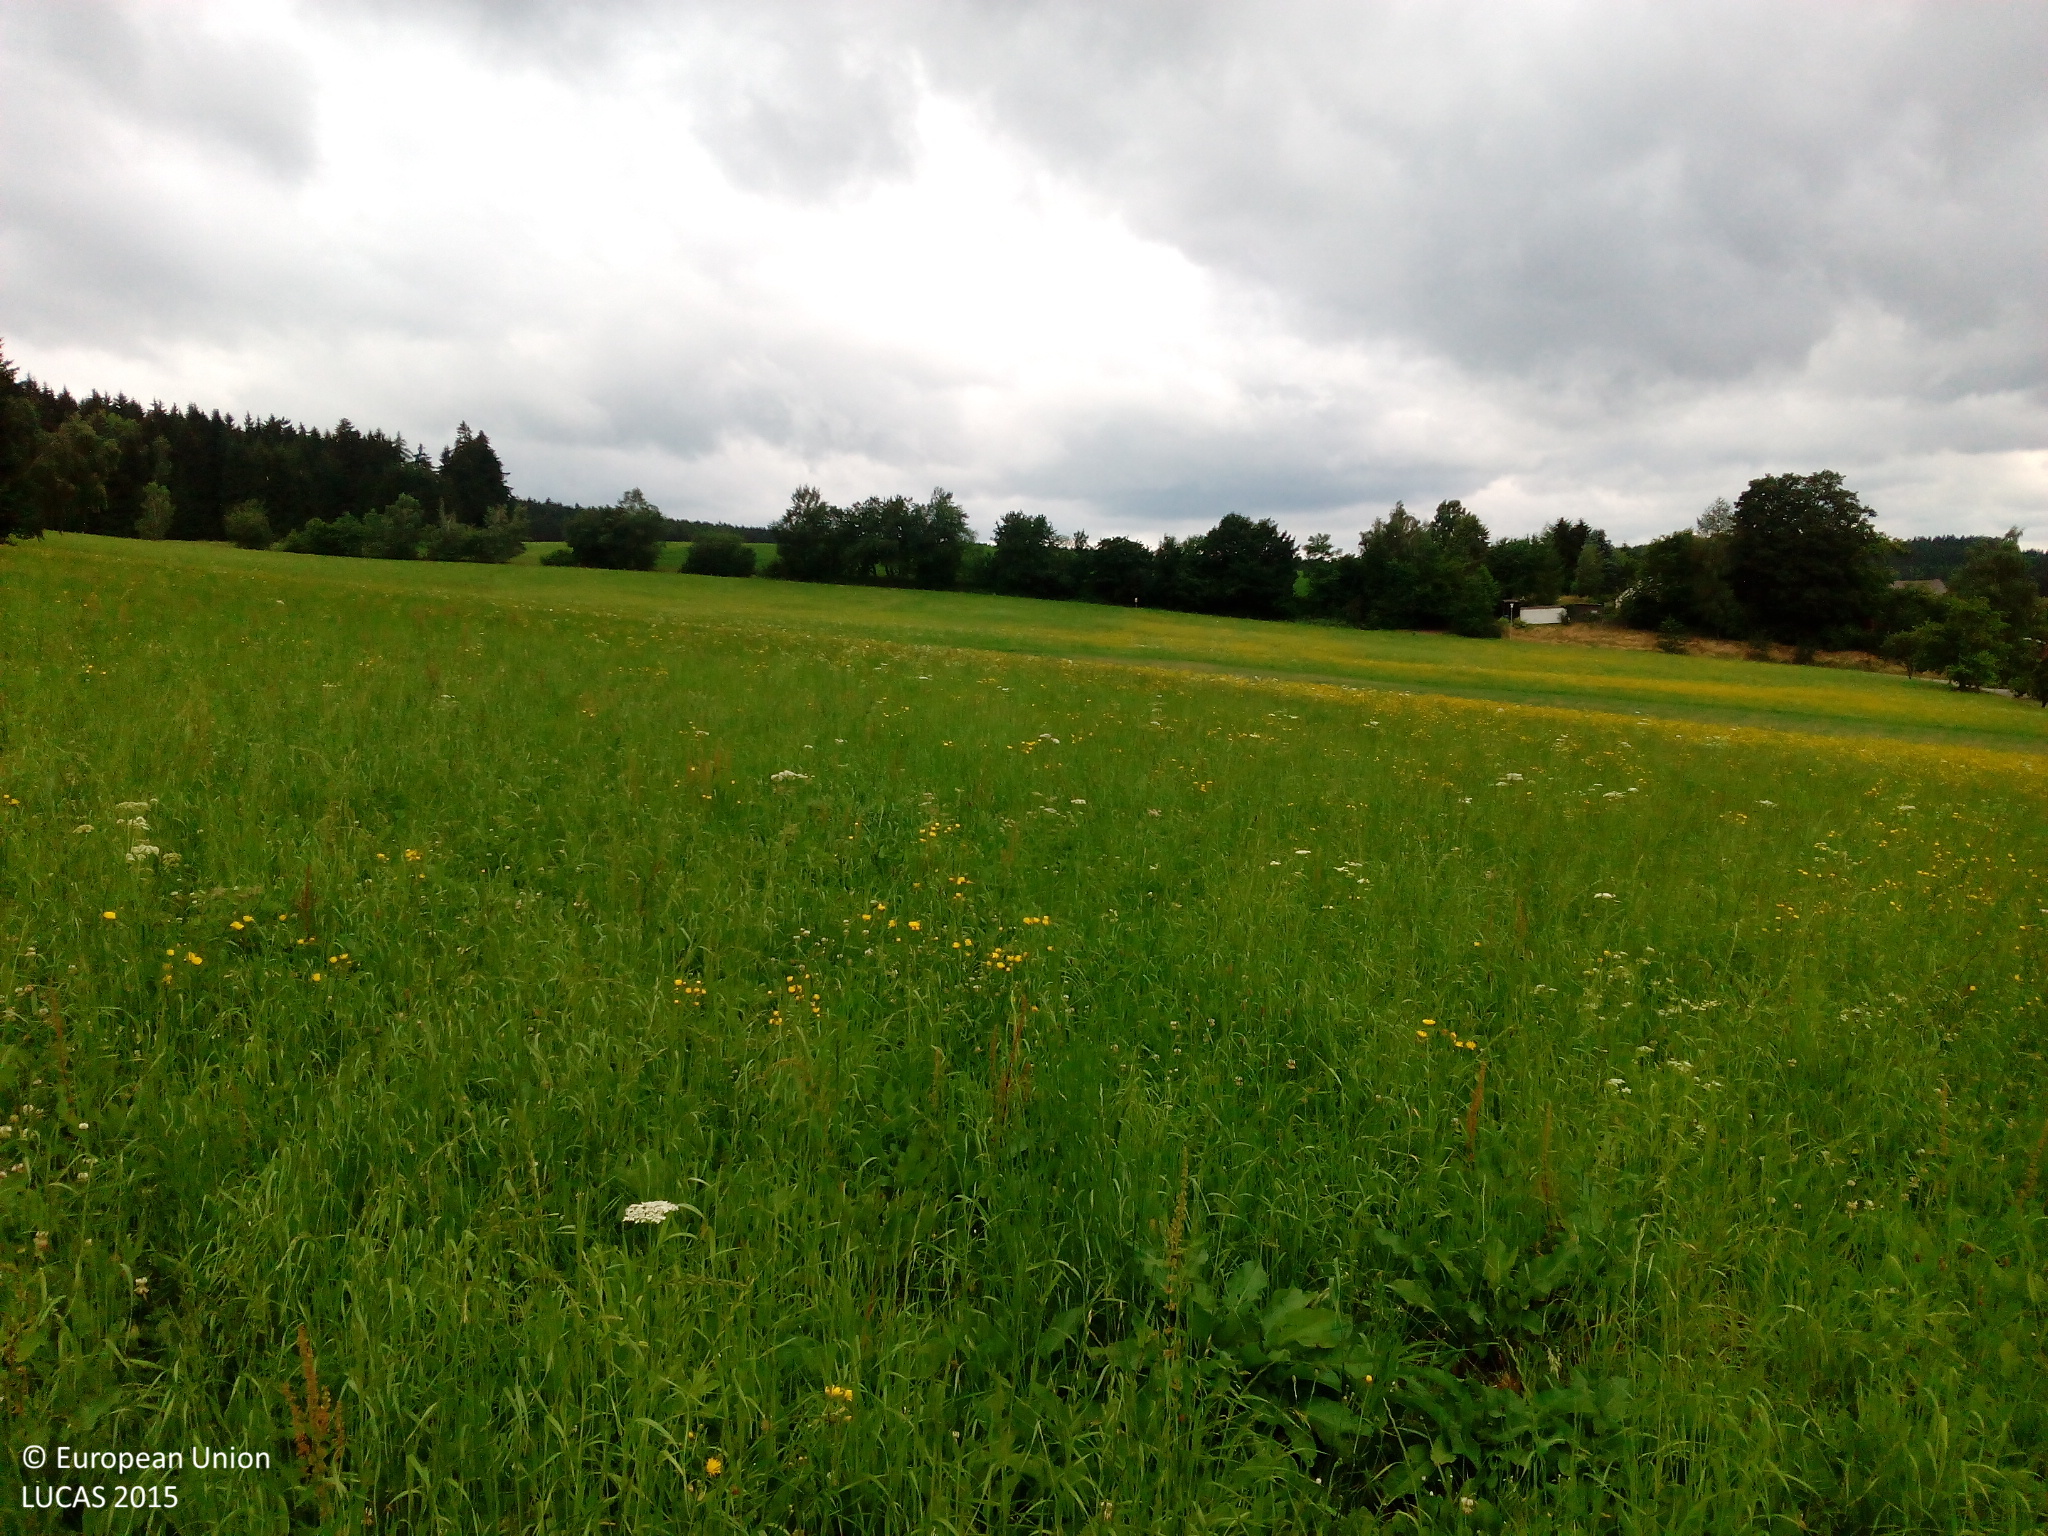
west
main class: Grassland
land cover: Grassland without tree/shrub cover
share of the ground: > 75 %
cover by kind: herbaceous plants 100 %
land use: Agriculture (excluding fallow land and kitchen gardens)
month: July
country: DE
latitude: 49.5469
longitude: 12.4183
